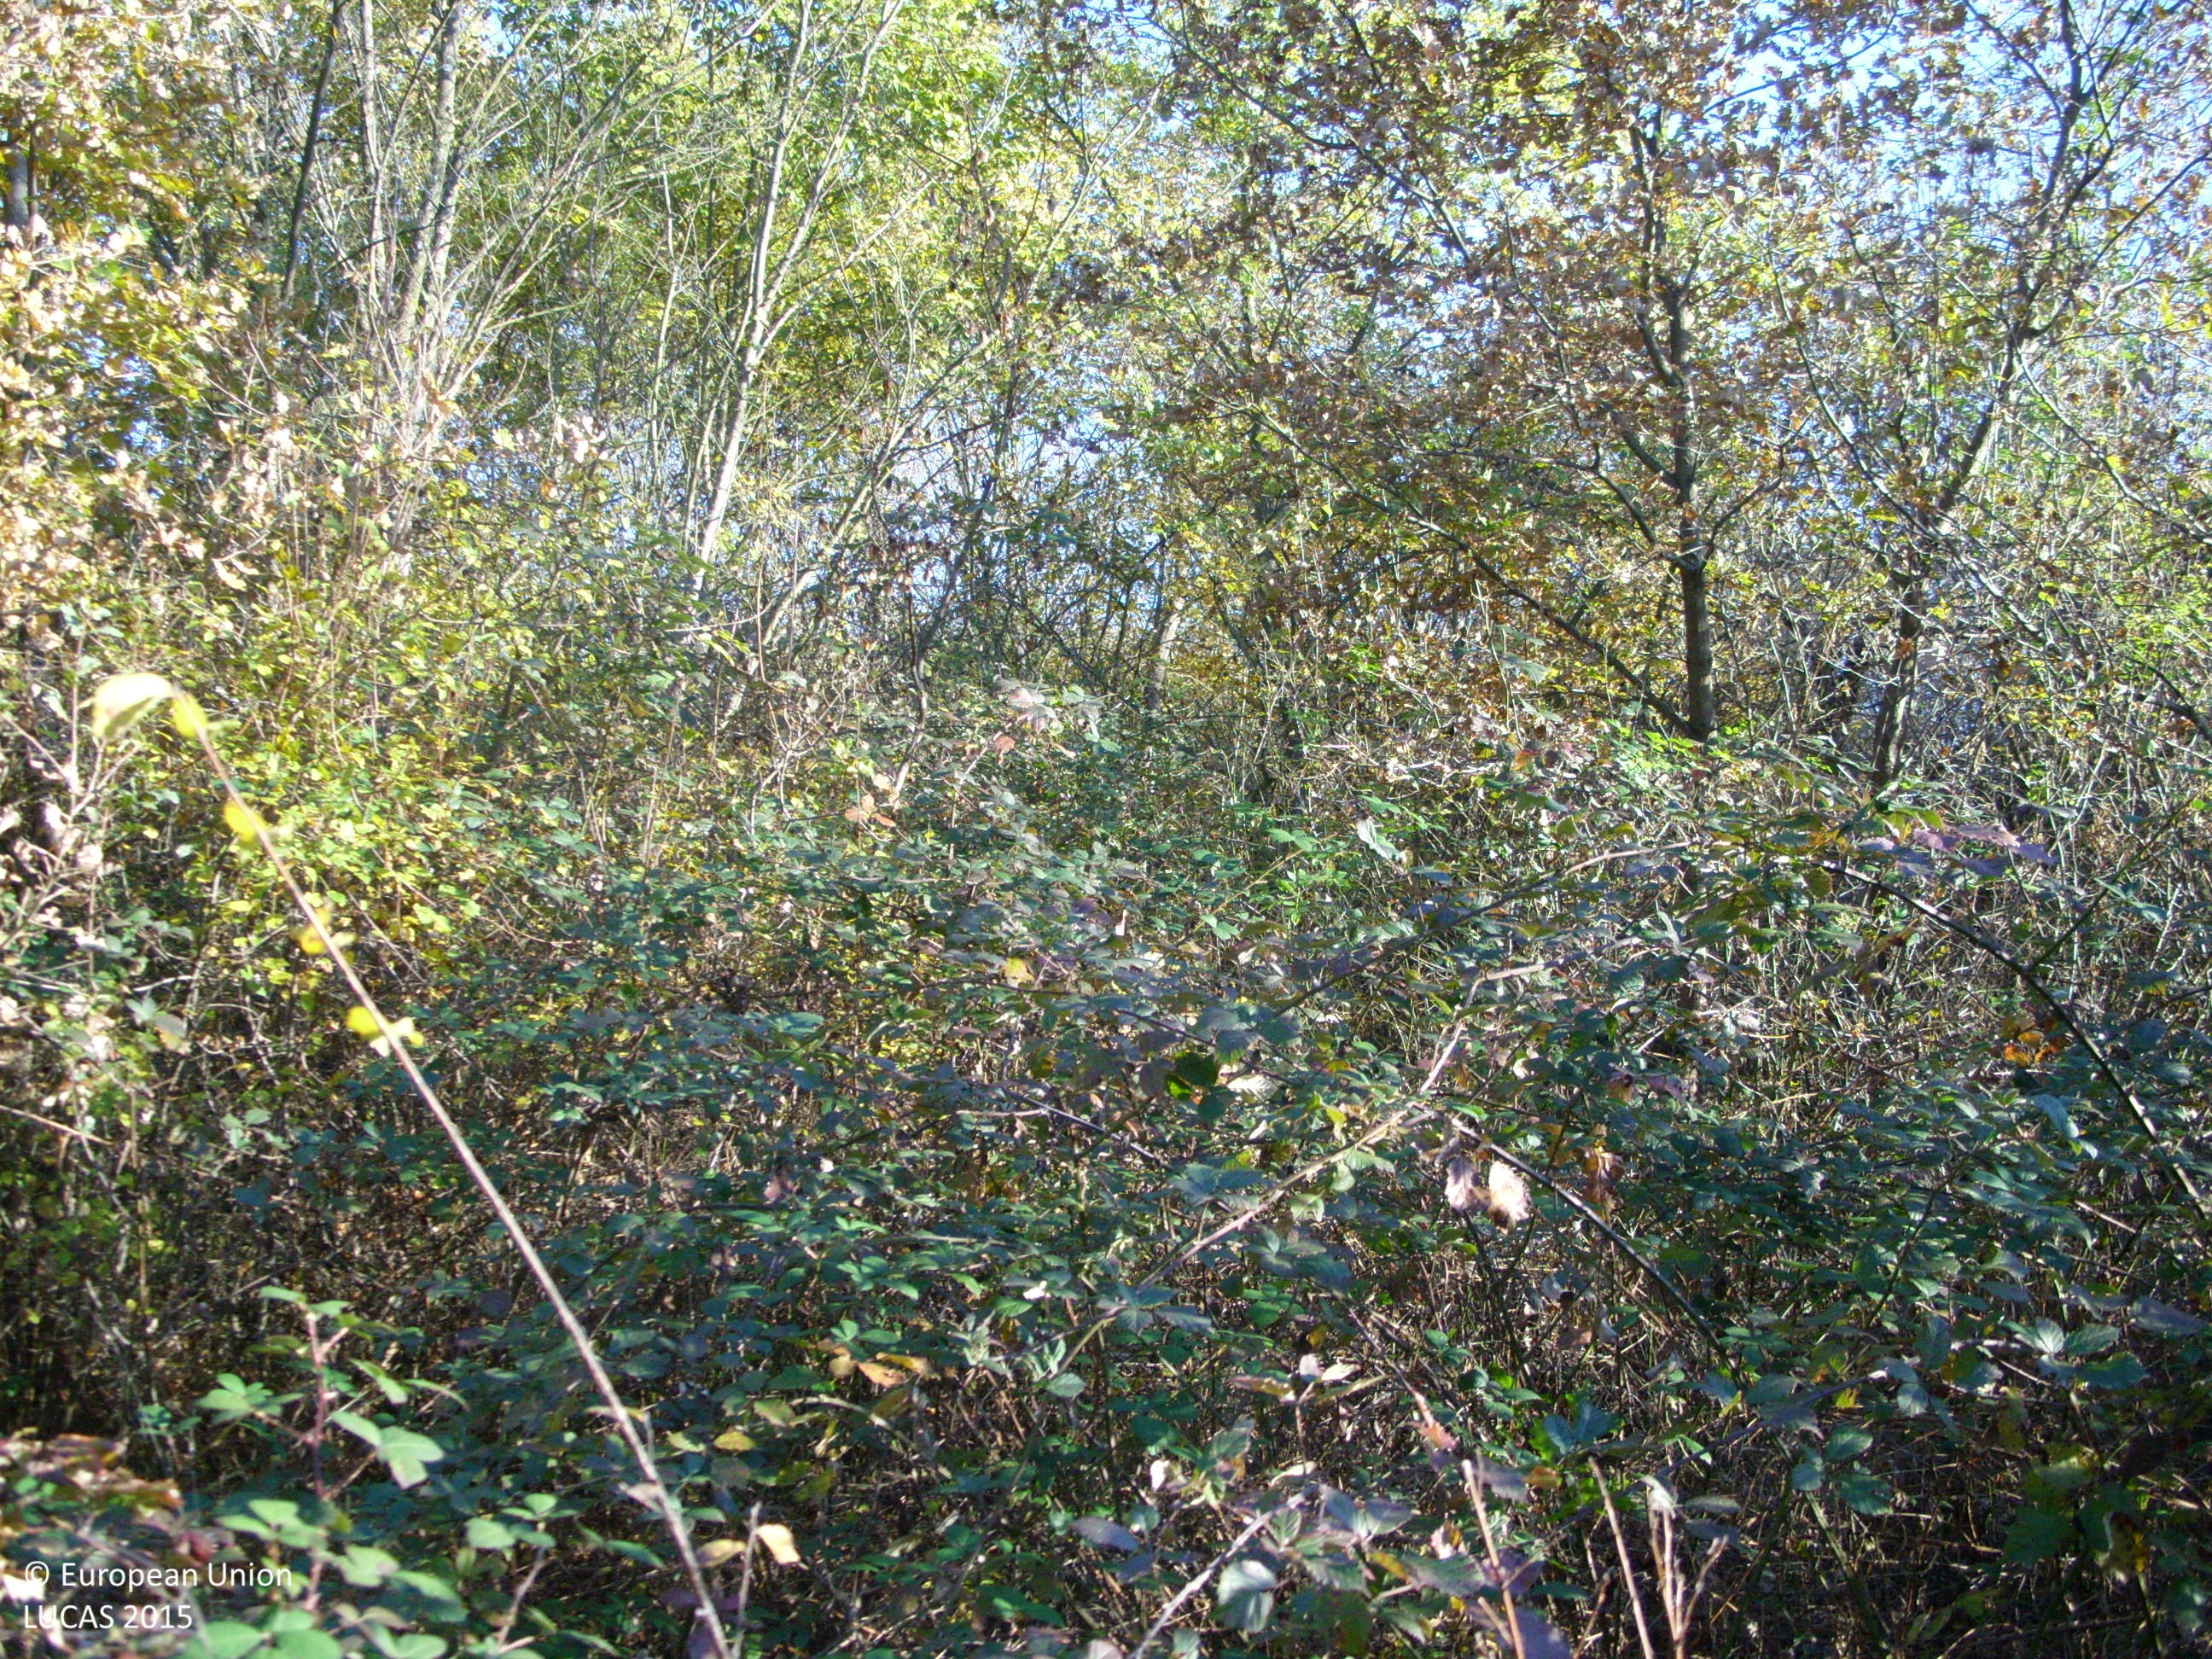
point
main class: Woodland
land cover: Broadleaved woodland
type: mesophytic deciduous forest
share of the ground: > 75 %
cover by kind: broadleaved forest trees 90 %, shrubs 5 %, unconsolidated bare surface 5 %
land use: Forestry
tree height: > 5 m
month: November
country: BG
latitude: 42.4005
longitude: 24.8170
